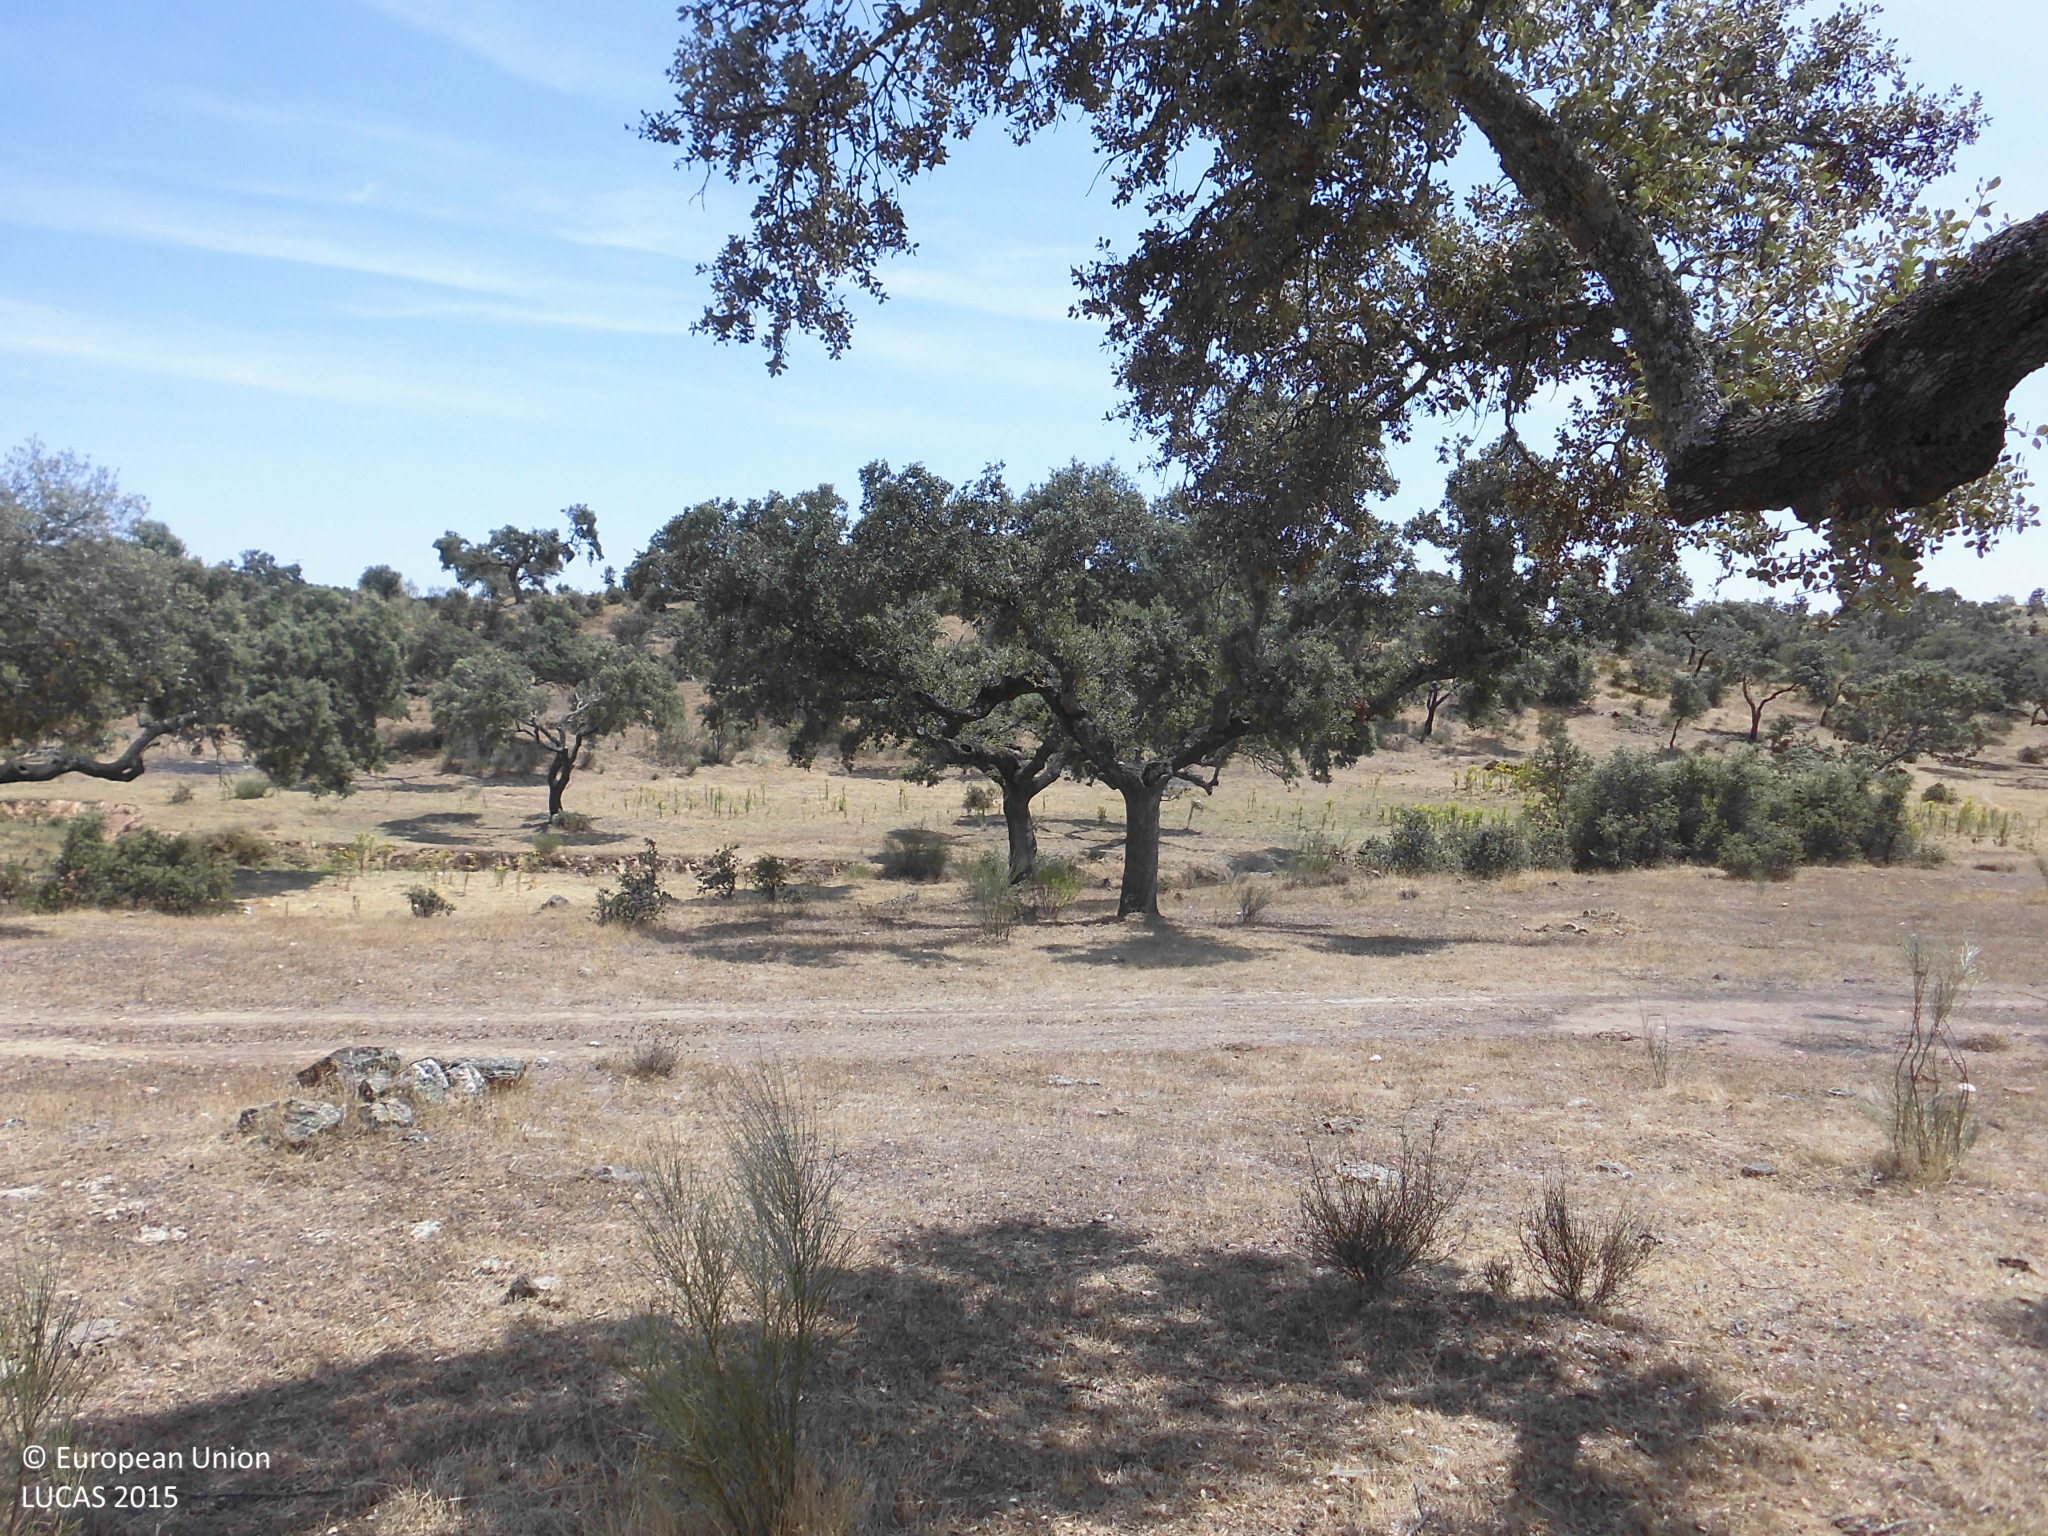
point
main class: Woodland
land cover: Broadleaved woodland
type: broadleaved evergreen forest
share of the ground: 10 - 25 %
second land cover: Grassland without tree/shrub cover
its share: > 75 %
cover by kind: herbaceous plants 85 %, broadleaved forest trees 15 %
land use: Forestry
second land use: Agriculture (excluding fallow land and kitchen gardens)
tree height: > 5 m
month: July
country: ES
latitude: 39.9032
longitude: -6.5360
